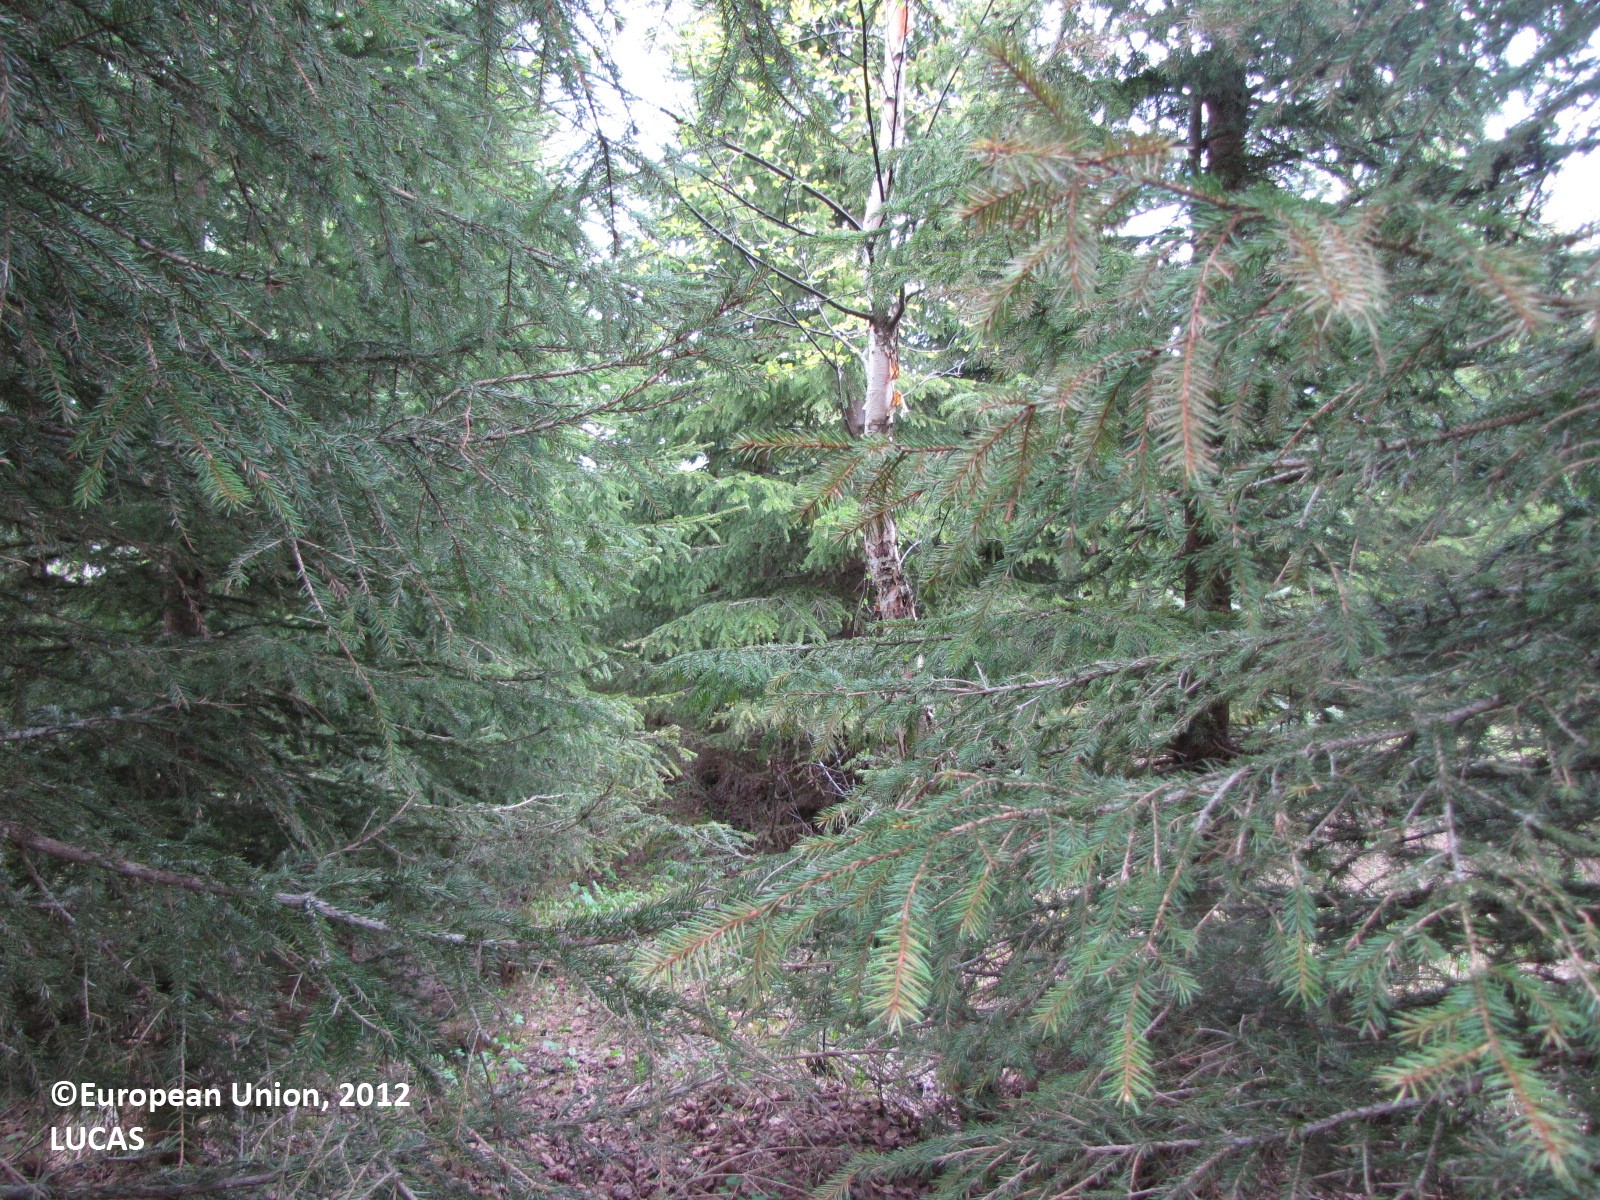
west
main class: Woodland
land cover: Spruce dominated coniferous woodland
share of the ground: > 75 %
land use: Forestry
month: June
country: FI
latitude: 65.8361
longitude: 24.4357
